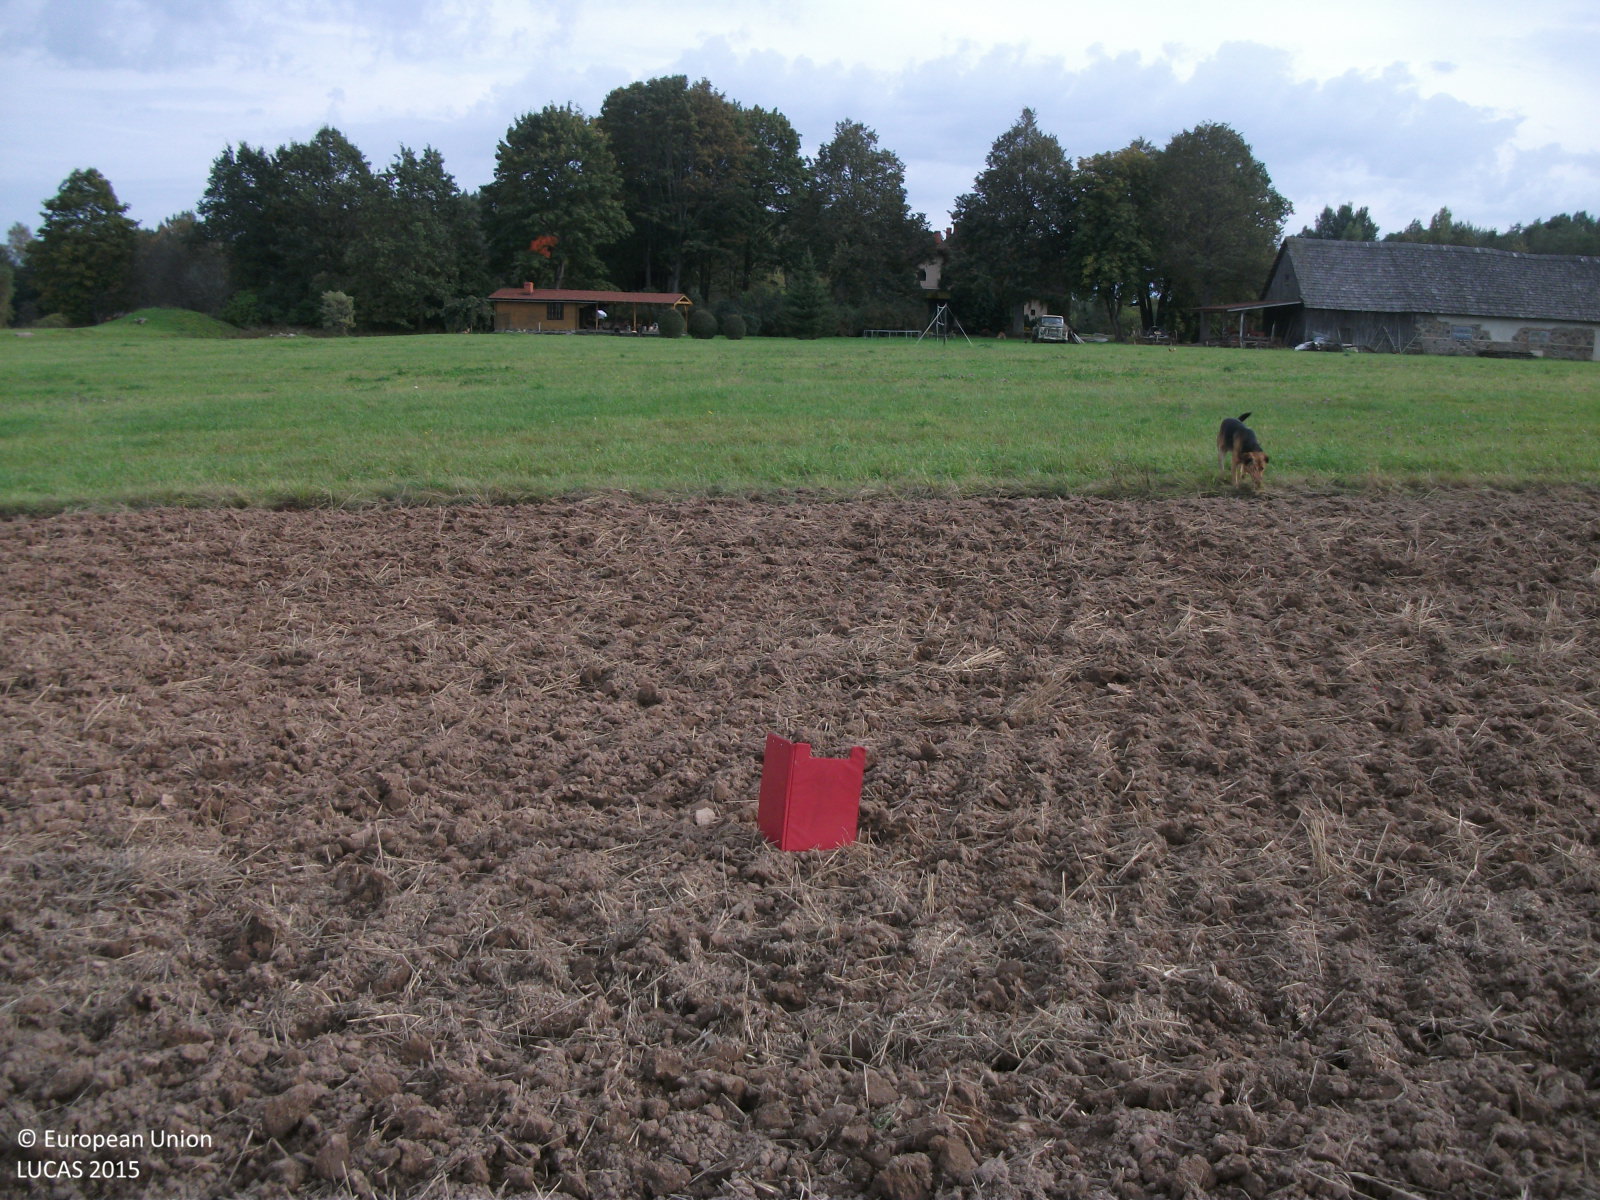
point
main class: Cropland
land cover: Common wheat
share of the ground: < 10 %
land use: Agriculture (excluding fallow land and kitchen gardens)
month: September
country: LV
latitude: 57.7562
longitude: 24.8354
